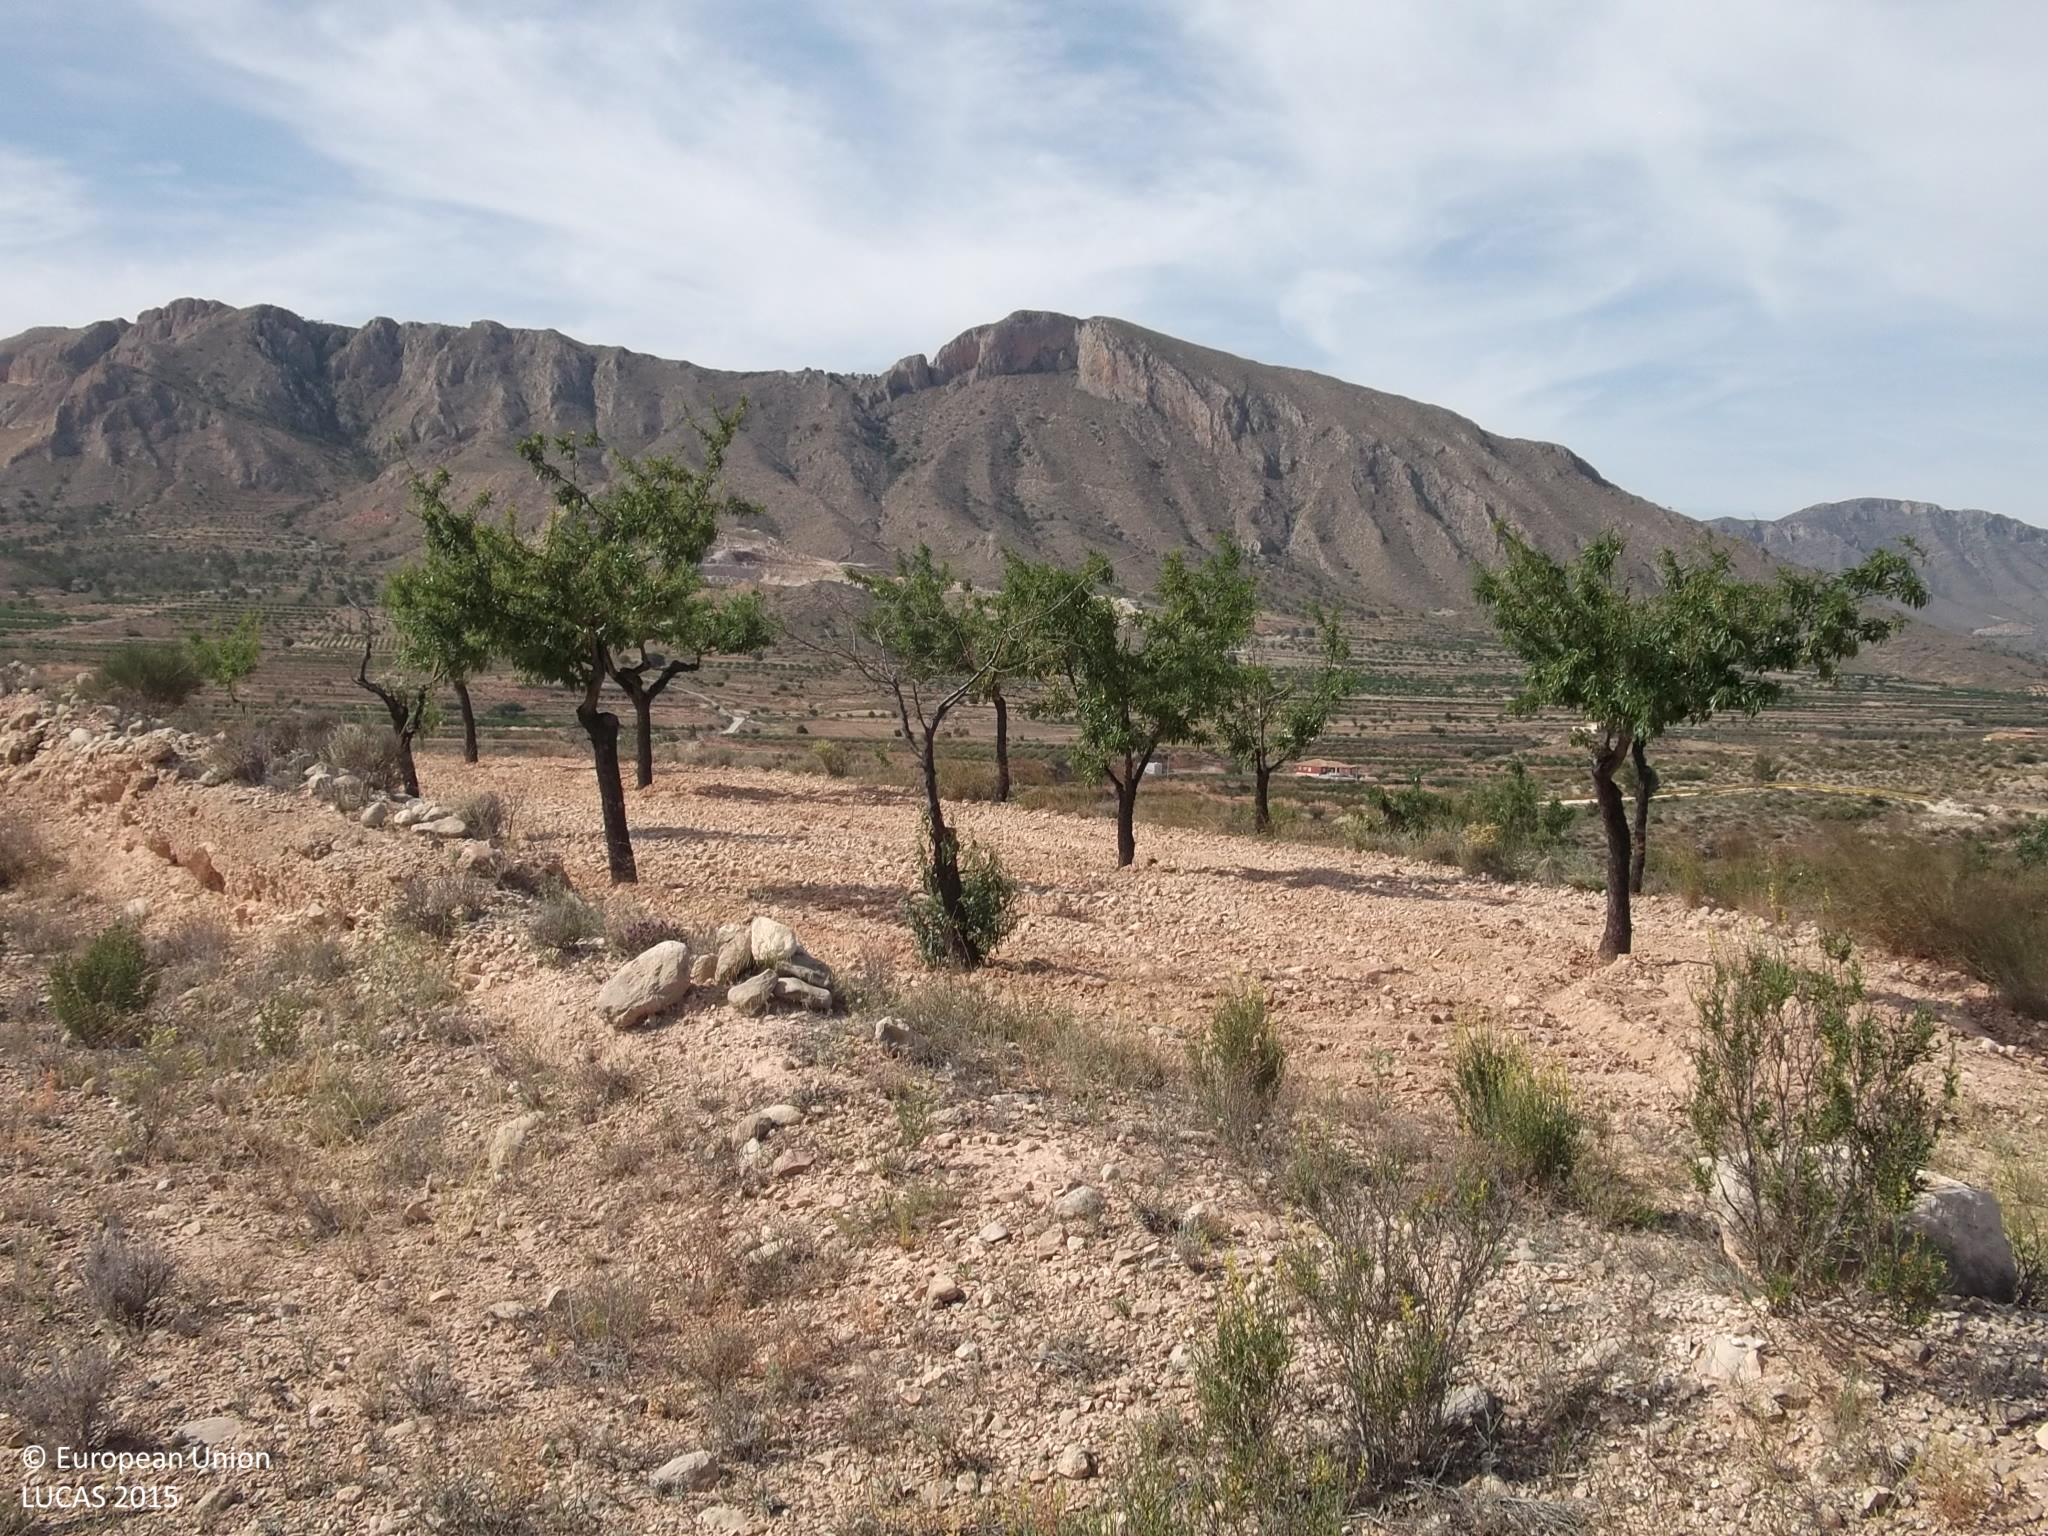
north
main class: Shrubland
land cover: Shrubland without tree cover
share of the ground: 10 - 25 %
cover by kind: consolidated bare surface 50 %, herbaceous plants 30 %, shrubs 20 %
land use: Abandoned areas
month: May
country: ES
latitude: 38.2600
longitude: -0.9922
